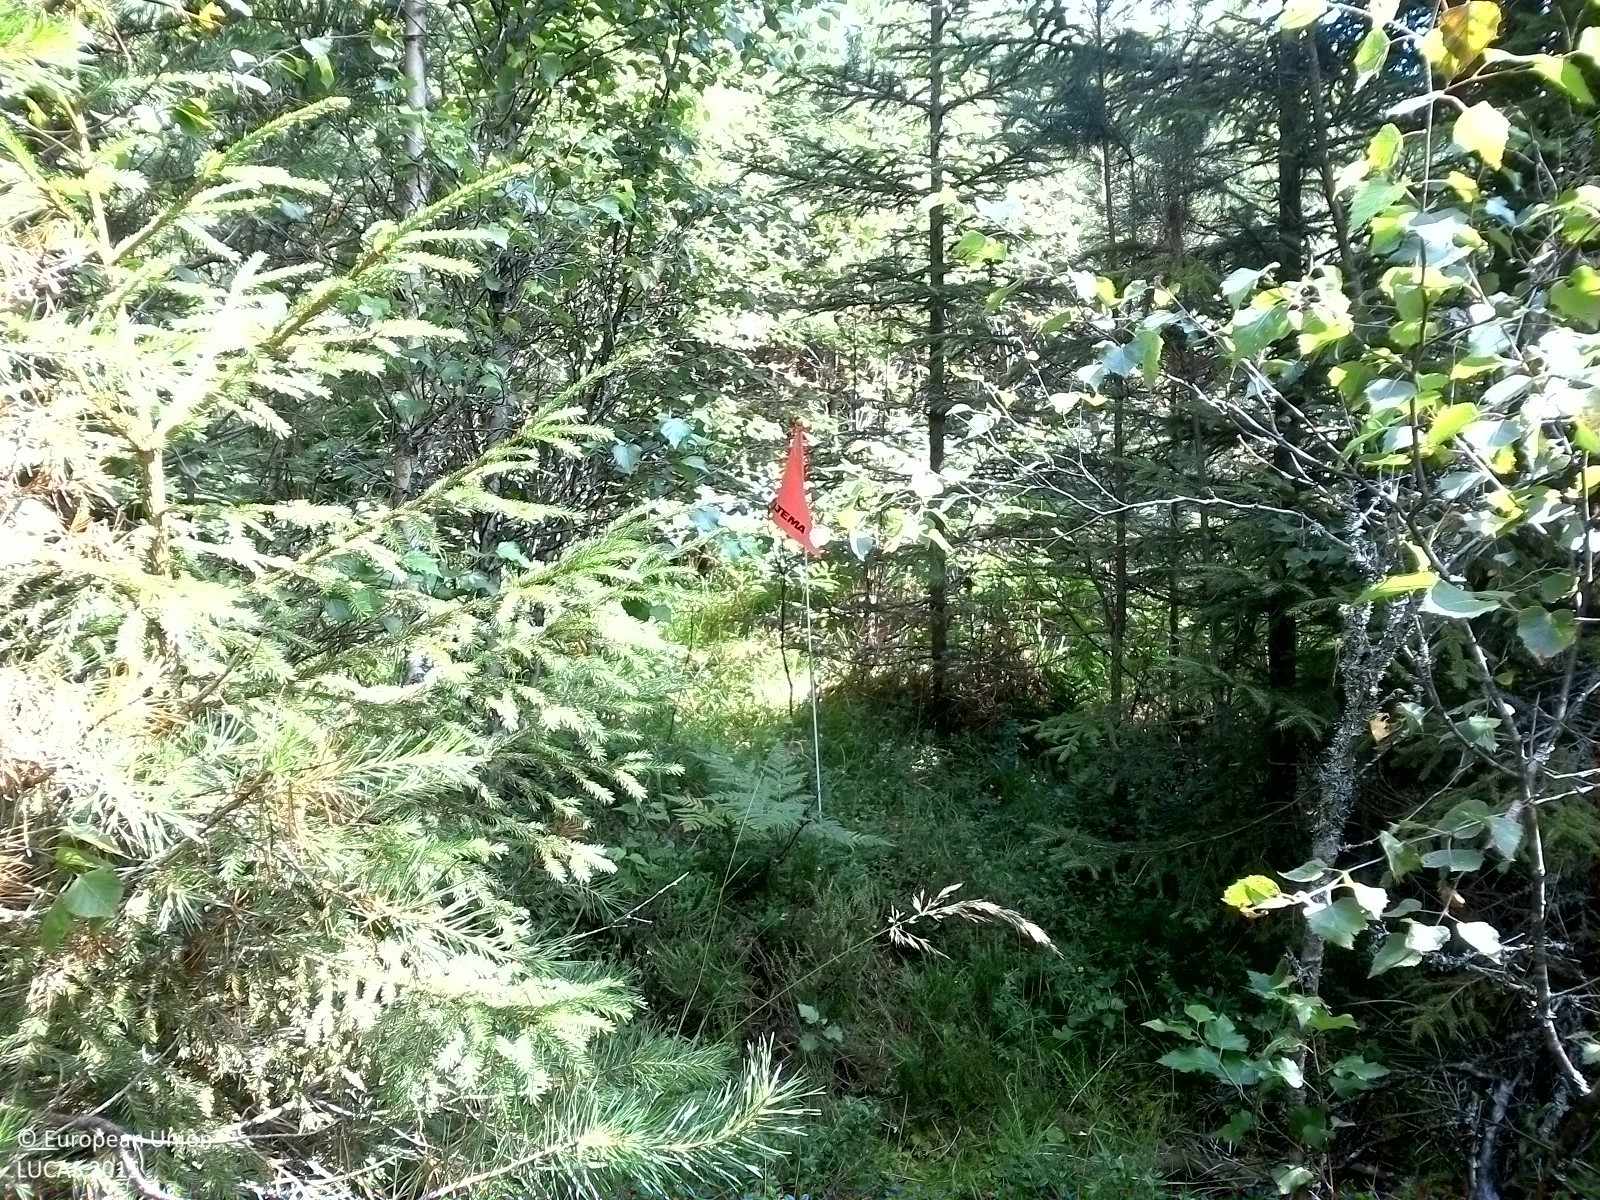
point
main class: Woodland
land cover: Other mixed woodland
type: boreal forest
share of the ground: > 75 %
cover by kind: coniferous forest trees 45 %, broadleaved forest trees 35 %, herbaceous plants 20 %
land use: Forestry
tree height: < 5 m
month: August
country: SE
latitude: 58.8691
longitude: 15.3862
